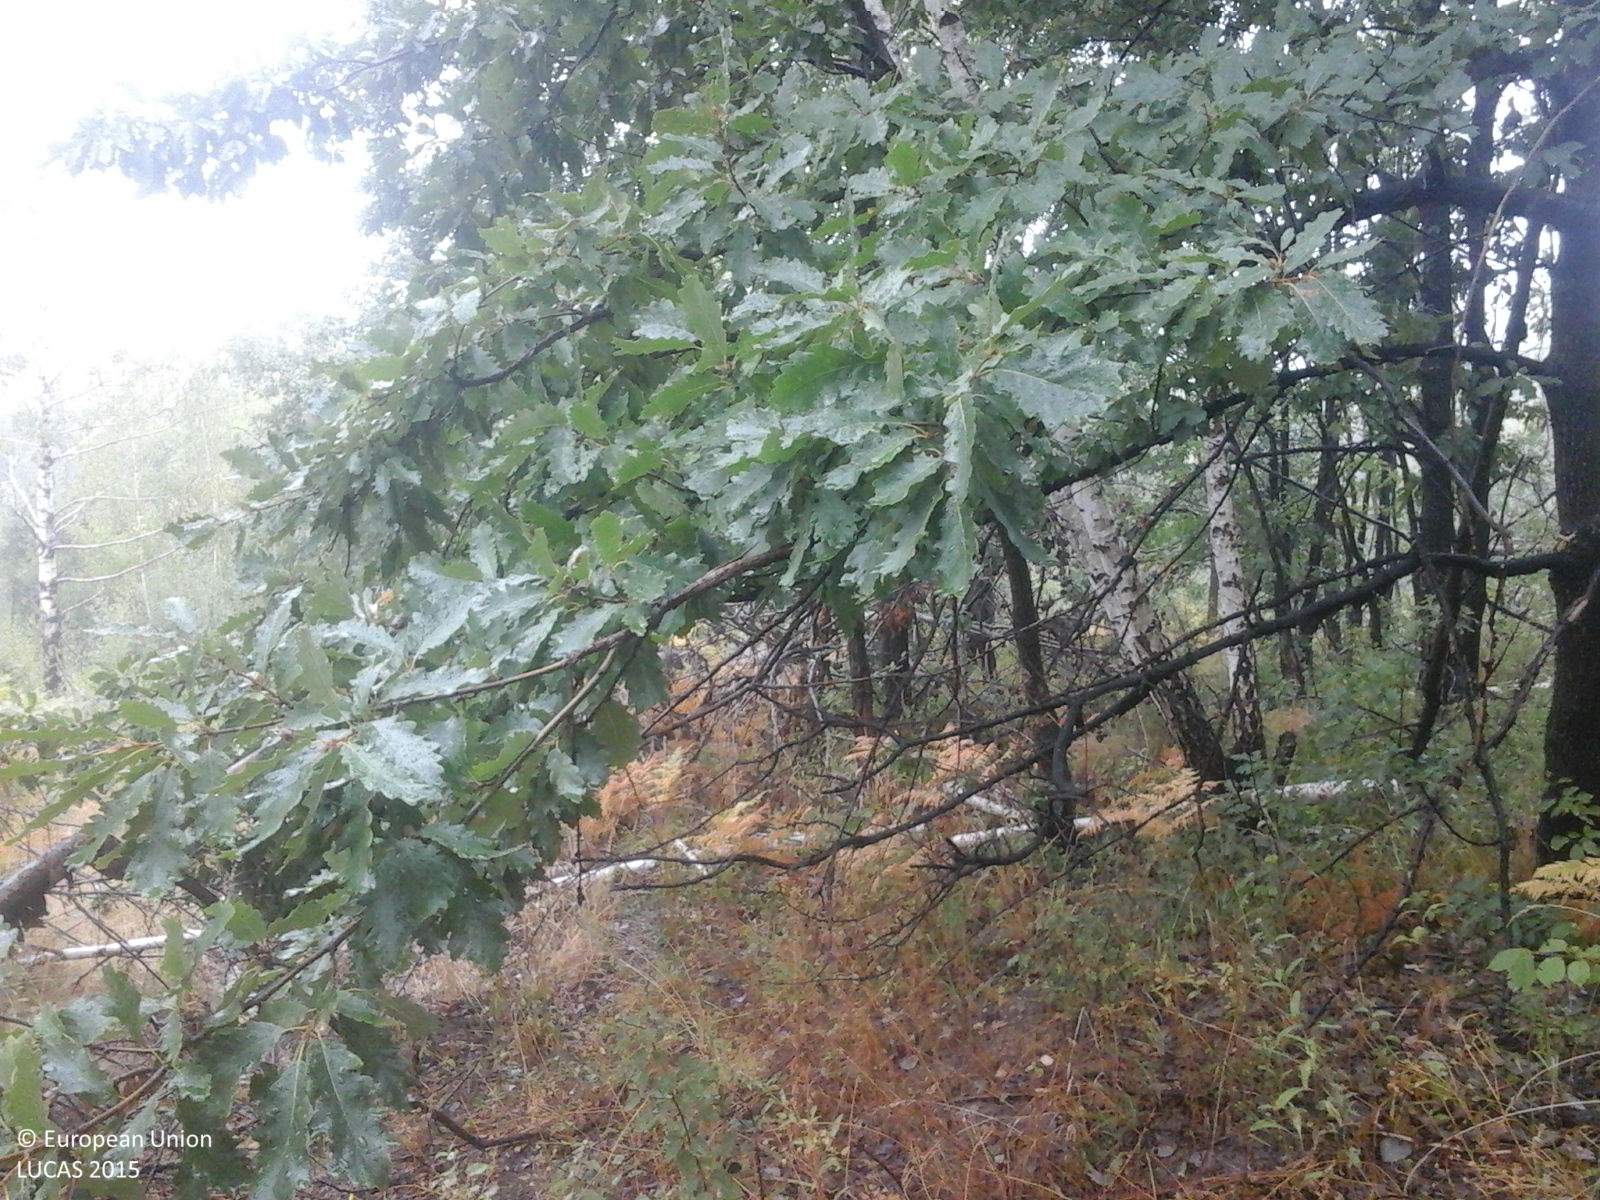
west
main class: Woodland
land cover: Broadleaved woodland
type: acidophilous oak and oak-birch forest
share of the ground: > 75 %
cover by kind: broadleaved forest trees 100 %
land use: Forestry
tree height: > 5 m
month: August
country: RO
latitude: 44.9614
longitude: 22.1694
